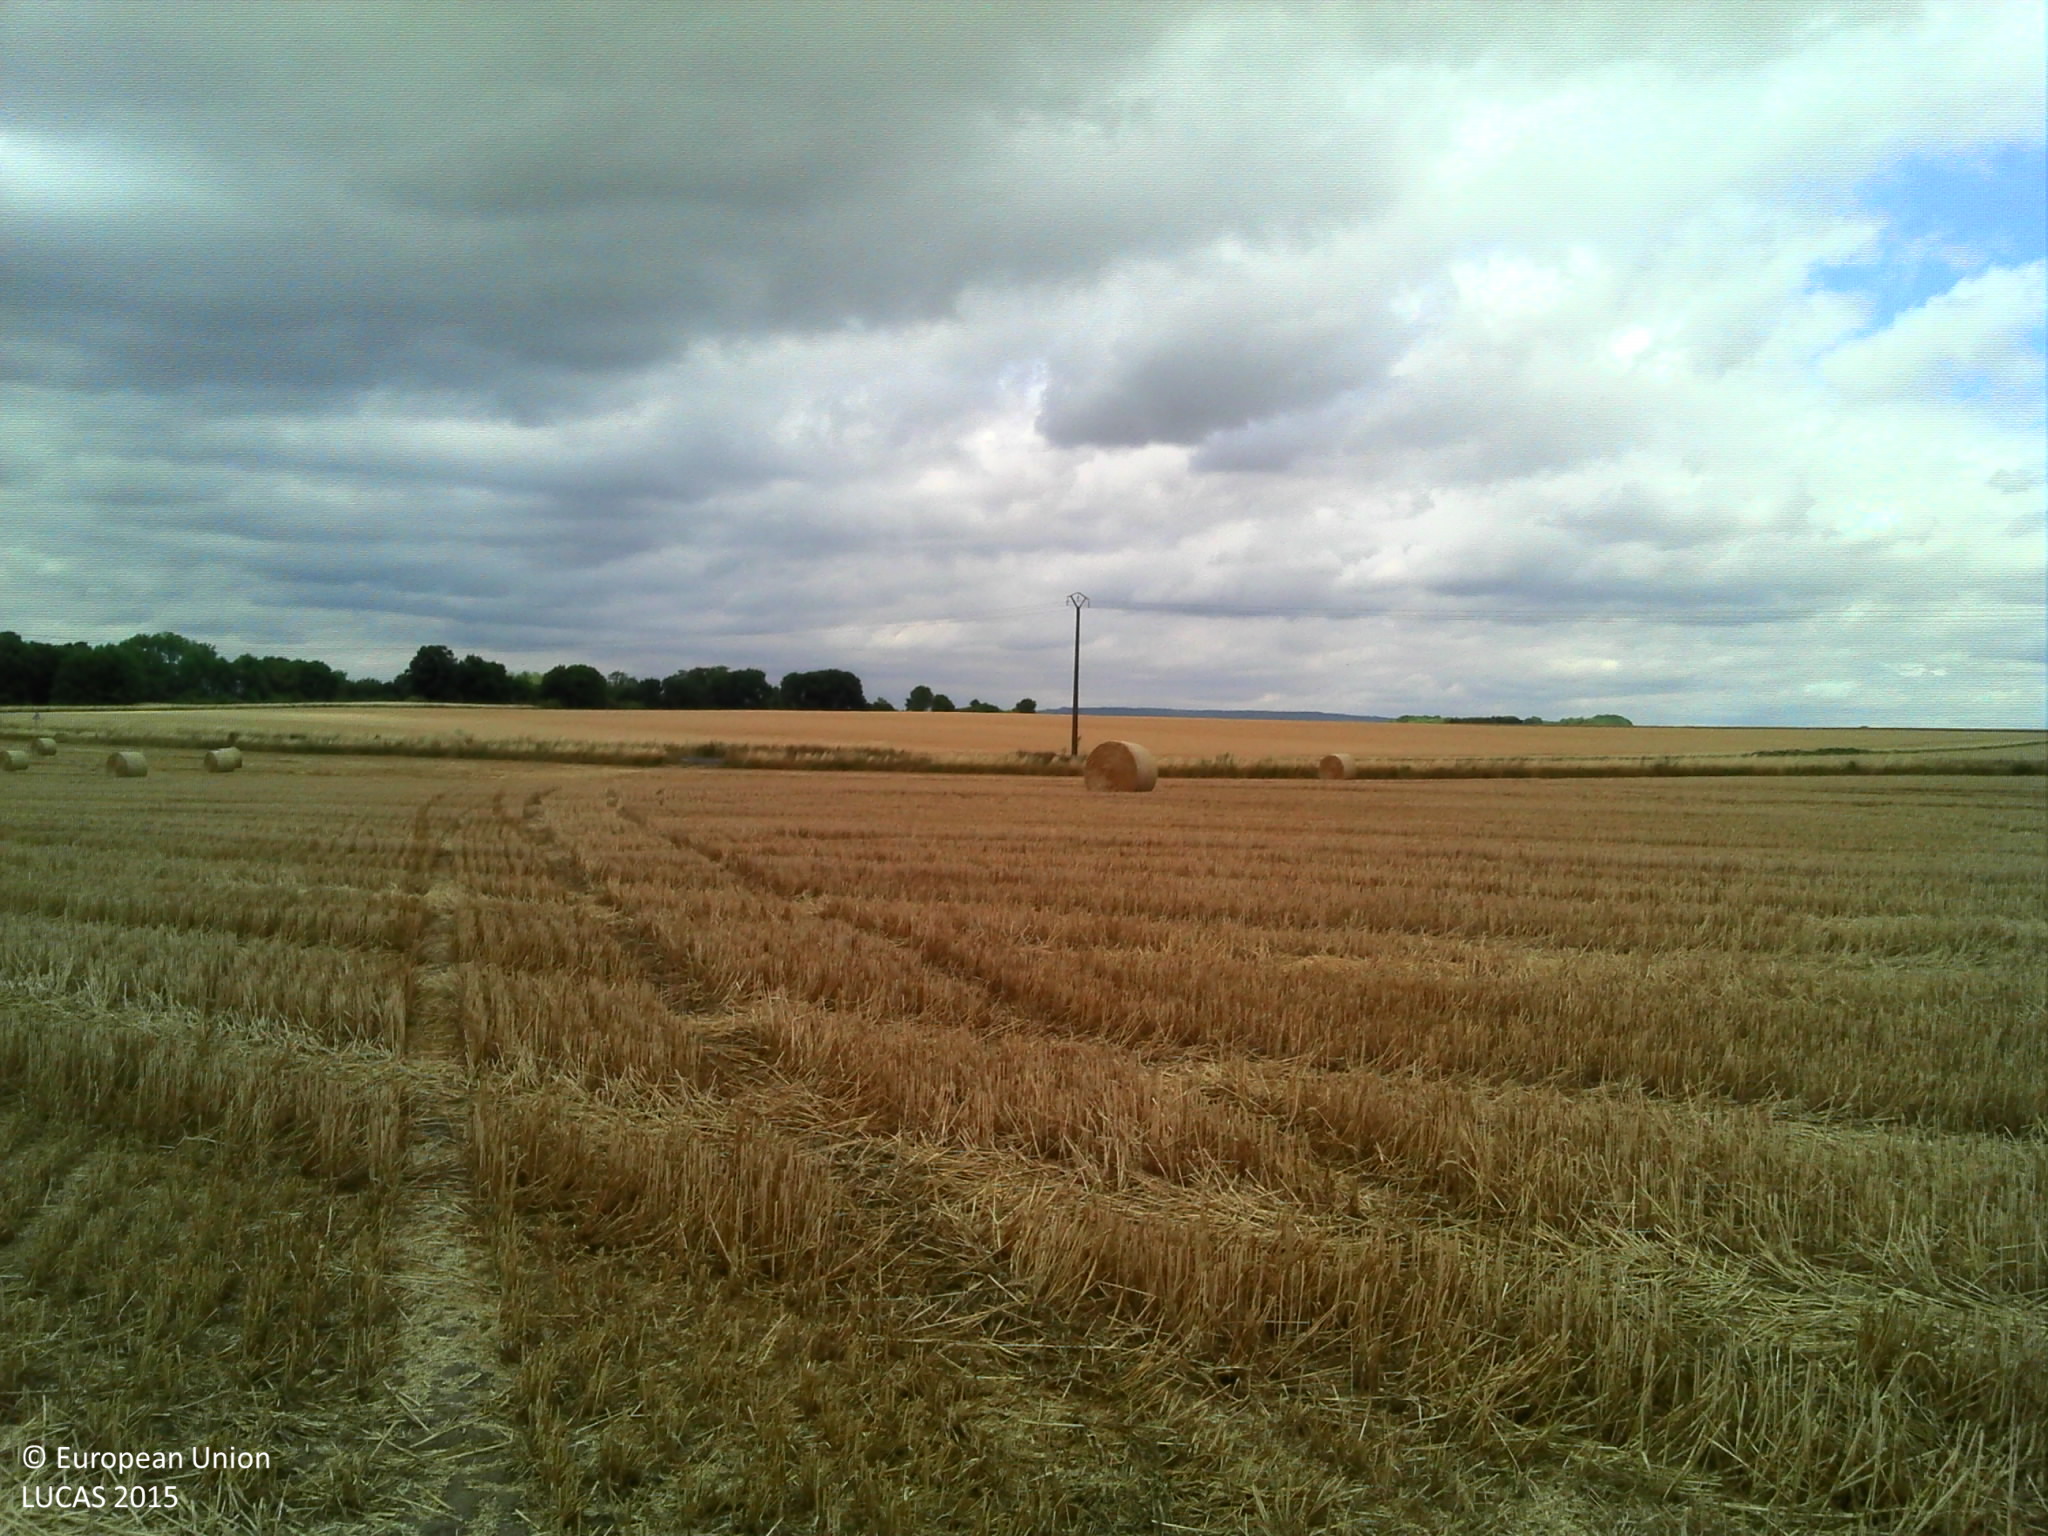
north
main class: Cropland
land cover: Common wheat
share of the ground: > 75 %
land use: Agriculture (excluding fallow land and kitchen gardens)
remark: Harvested field
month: July
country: FR
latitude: 49.1883
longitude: 2.6485
